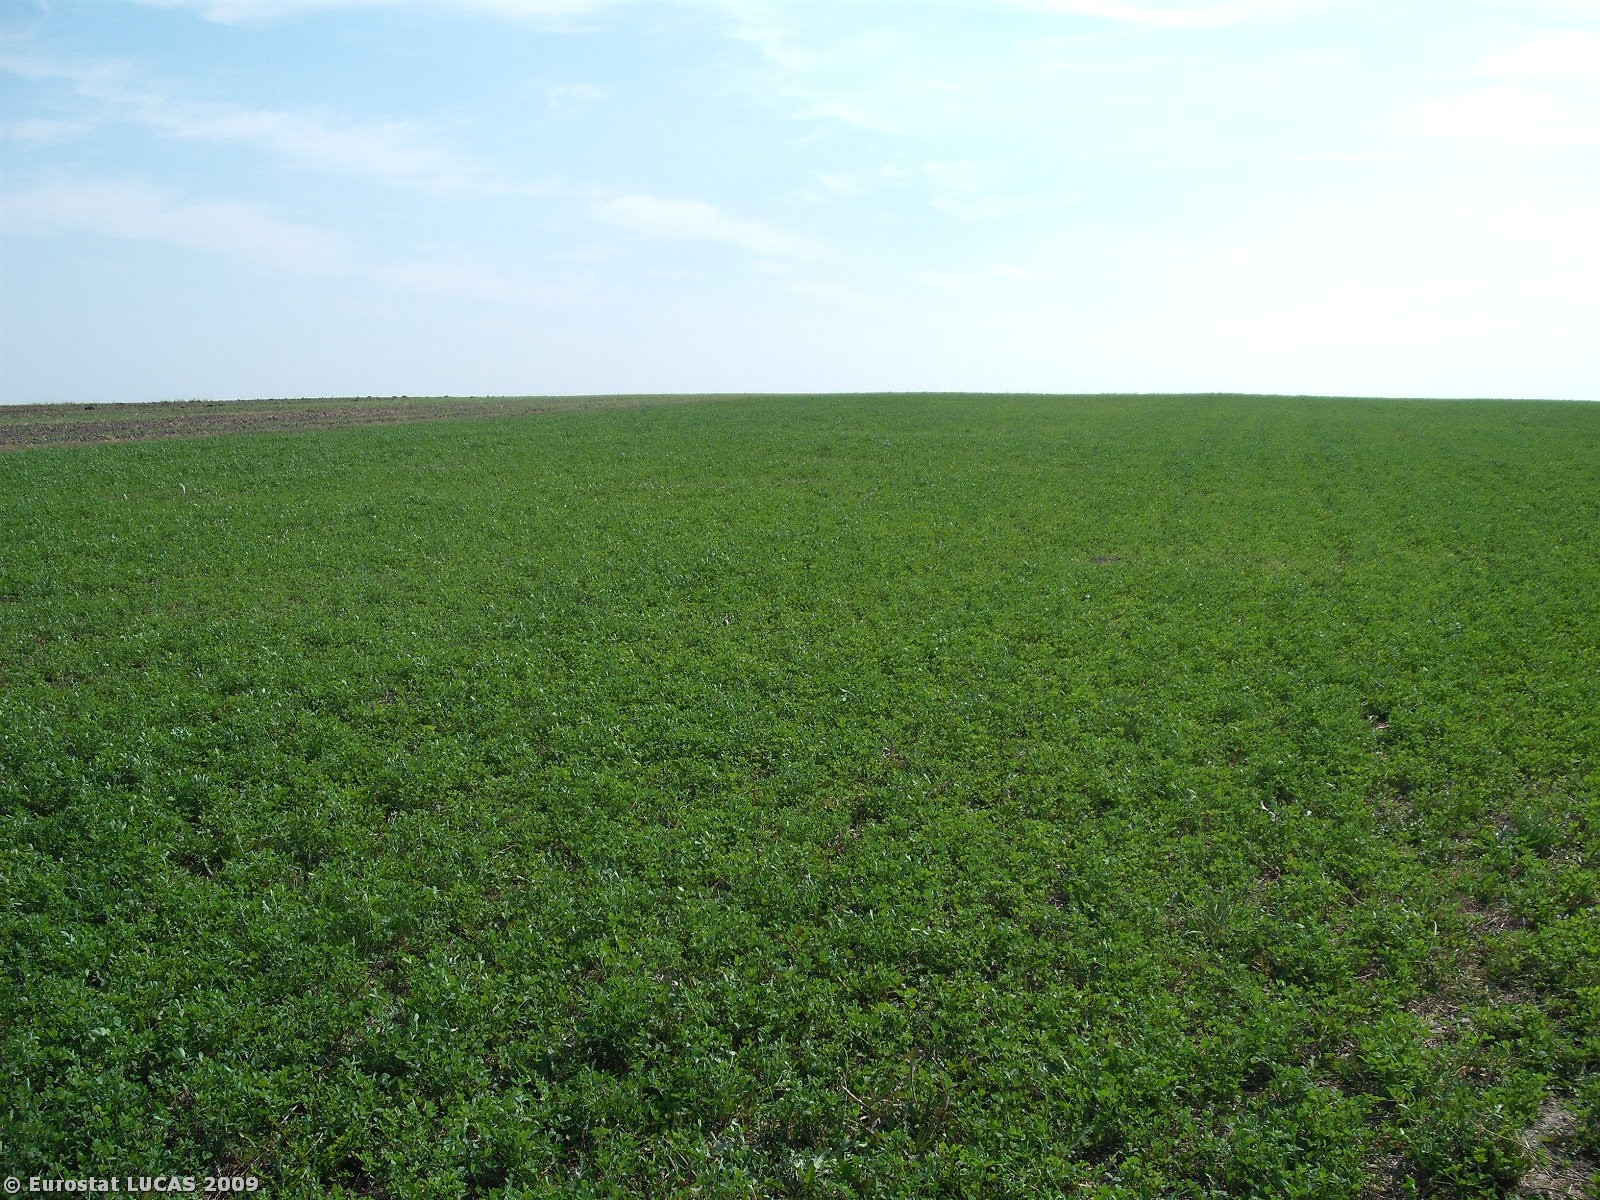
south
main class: Cropland
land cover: Lucerne
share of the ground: > 75 %
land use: Agriculture (excluding fallow land and kitchen gardens)
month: September
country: PL
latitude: 50.5457
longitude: 20.3522
